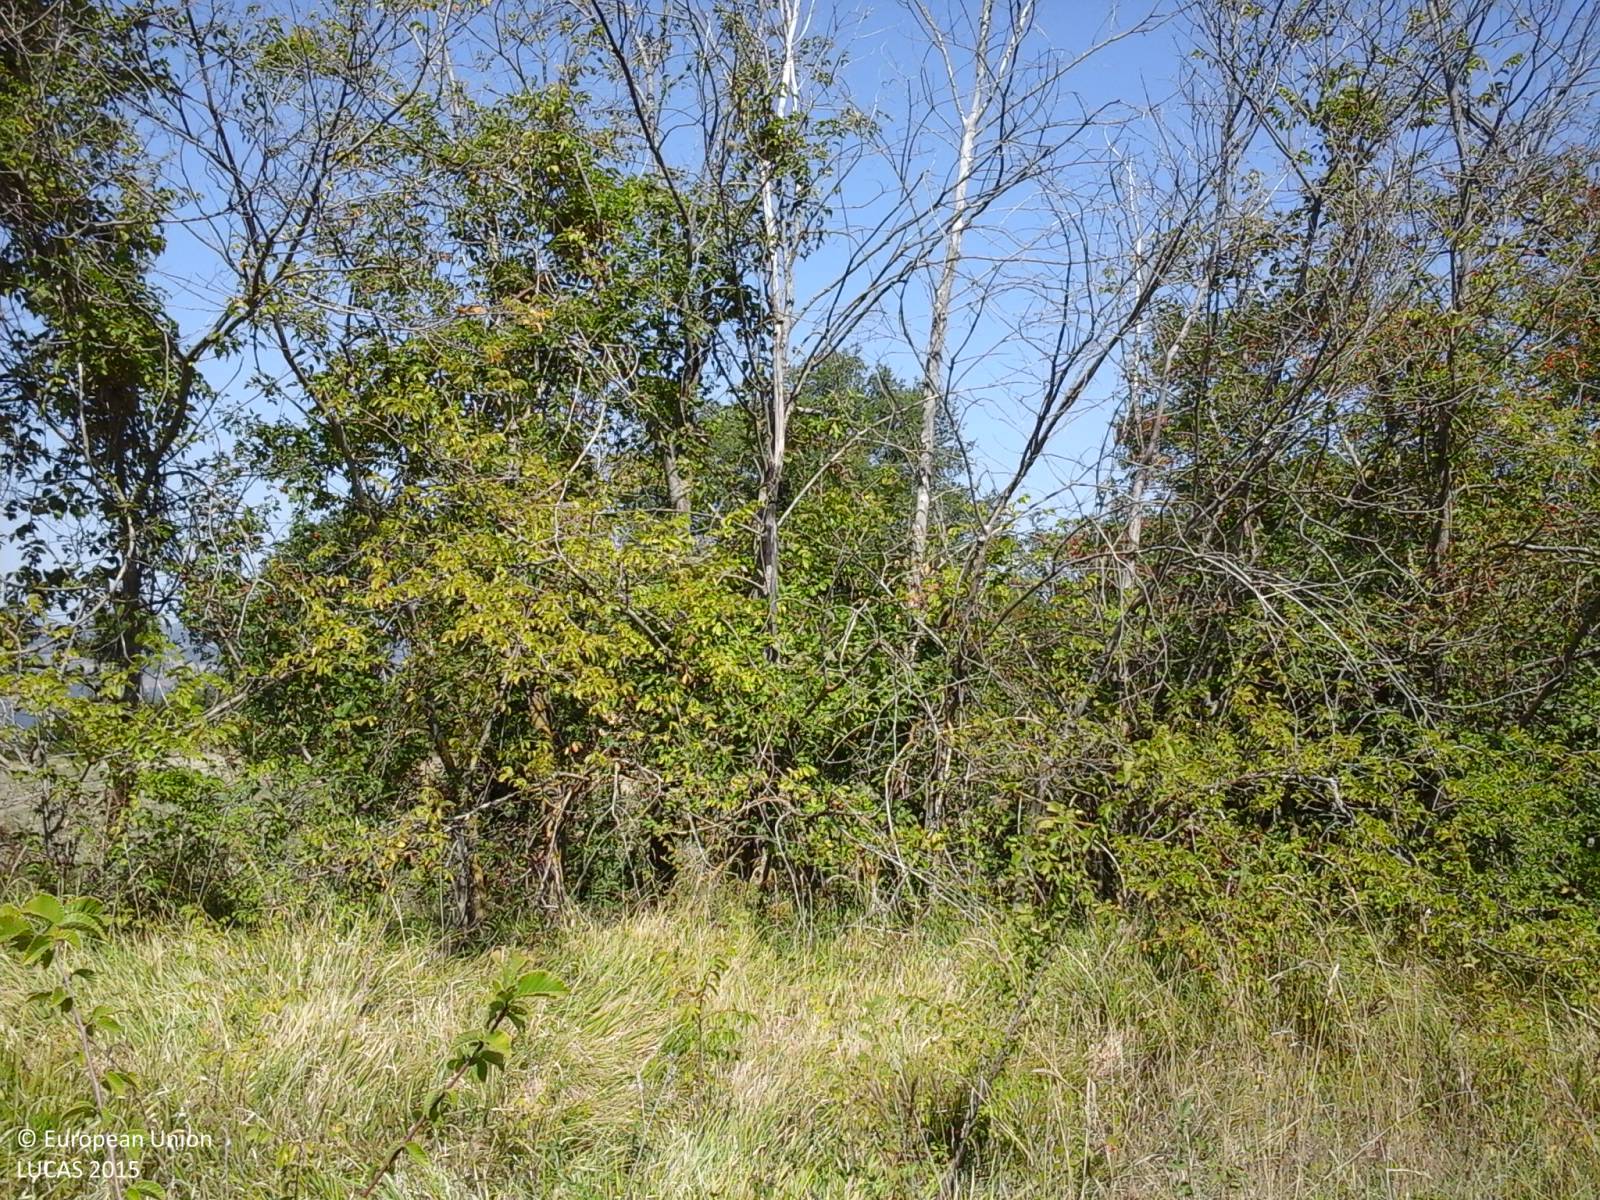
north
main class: Shrubland
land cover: Shrubland with sparse tree cover
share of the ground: 50 - 75 %
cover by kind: shrubs 55 %, herbaceous plants 40 %, broadleaved forest trees 5 %
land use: Abandoned areas
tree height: < 5 m
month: September
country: IT
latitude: 43.1256
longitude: 12.6352
